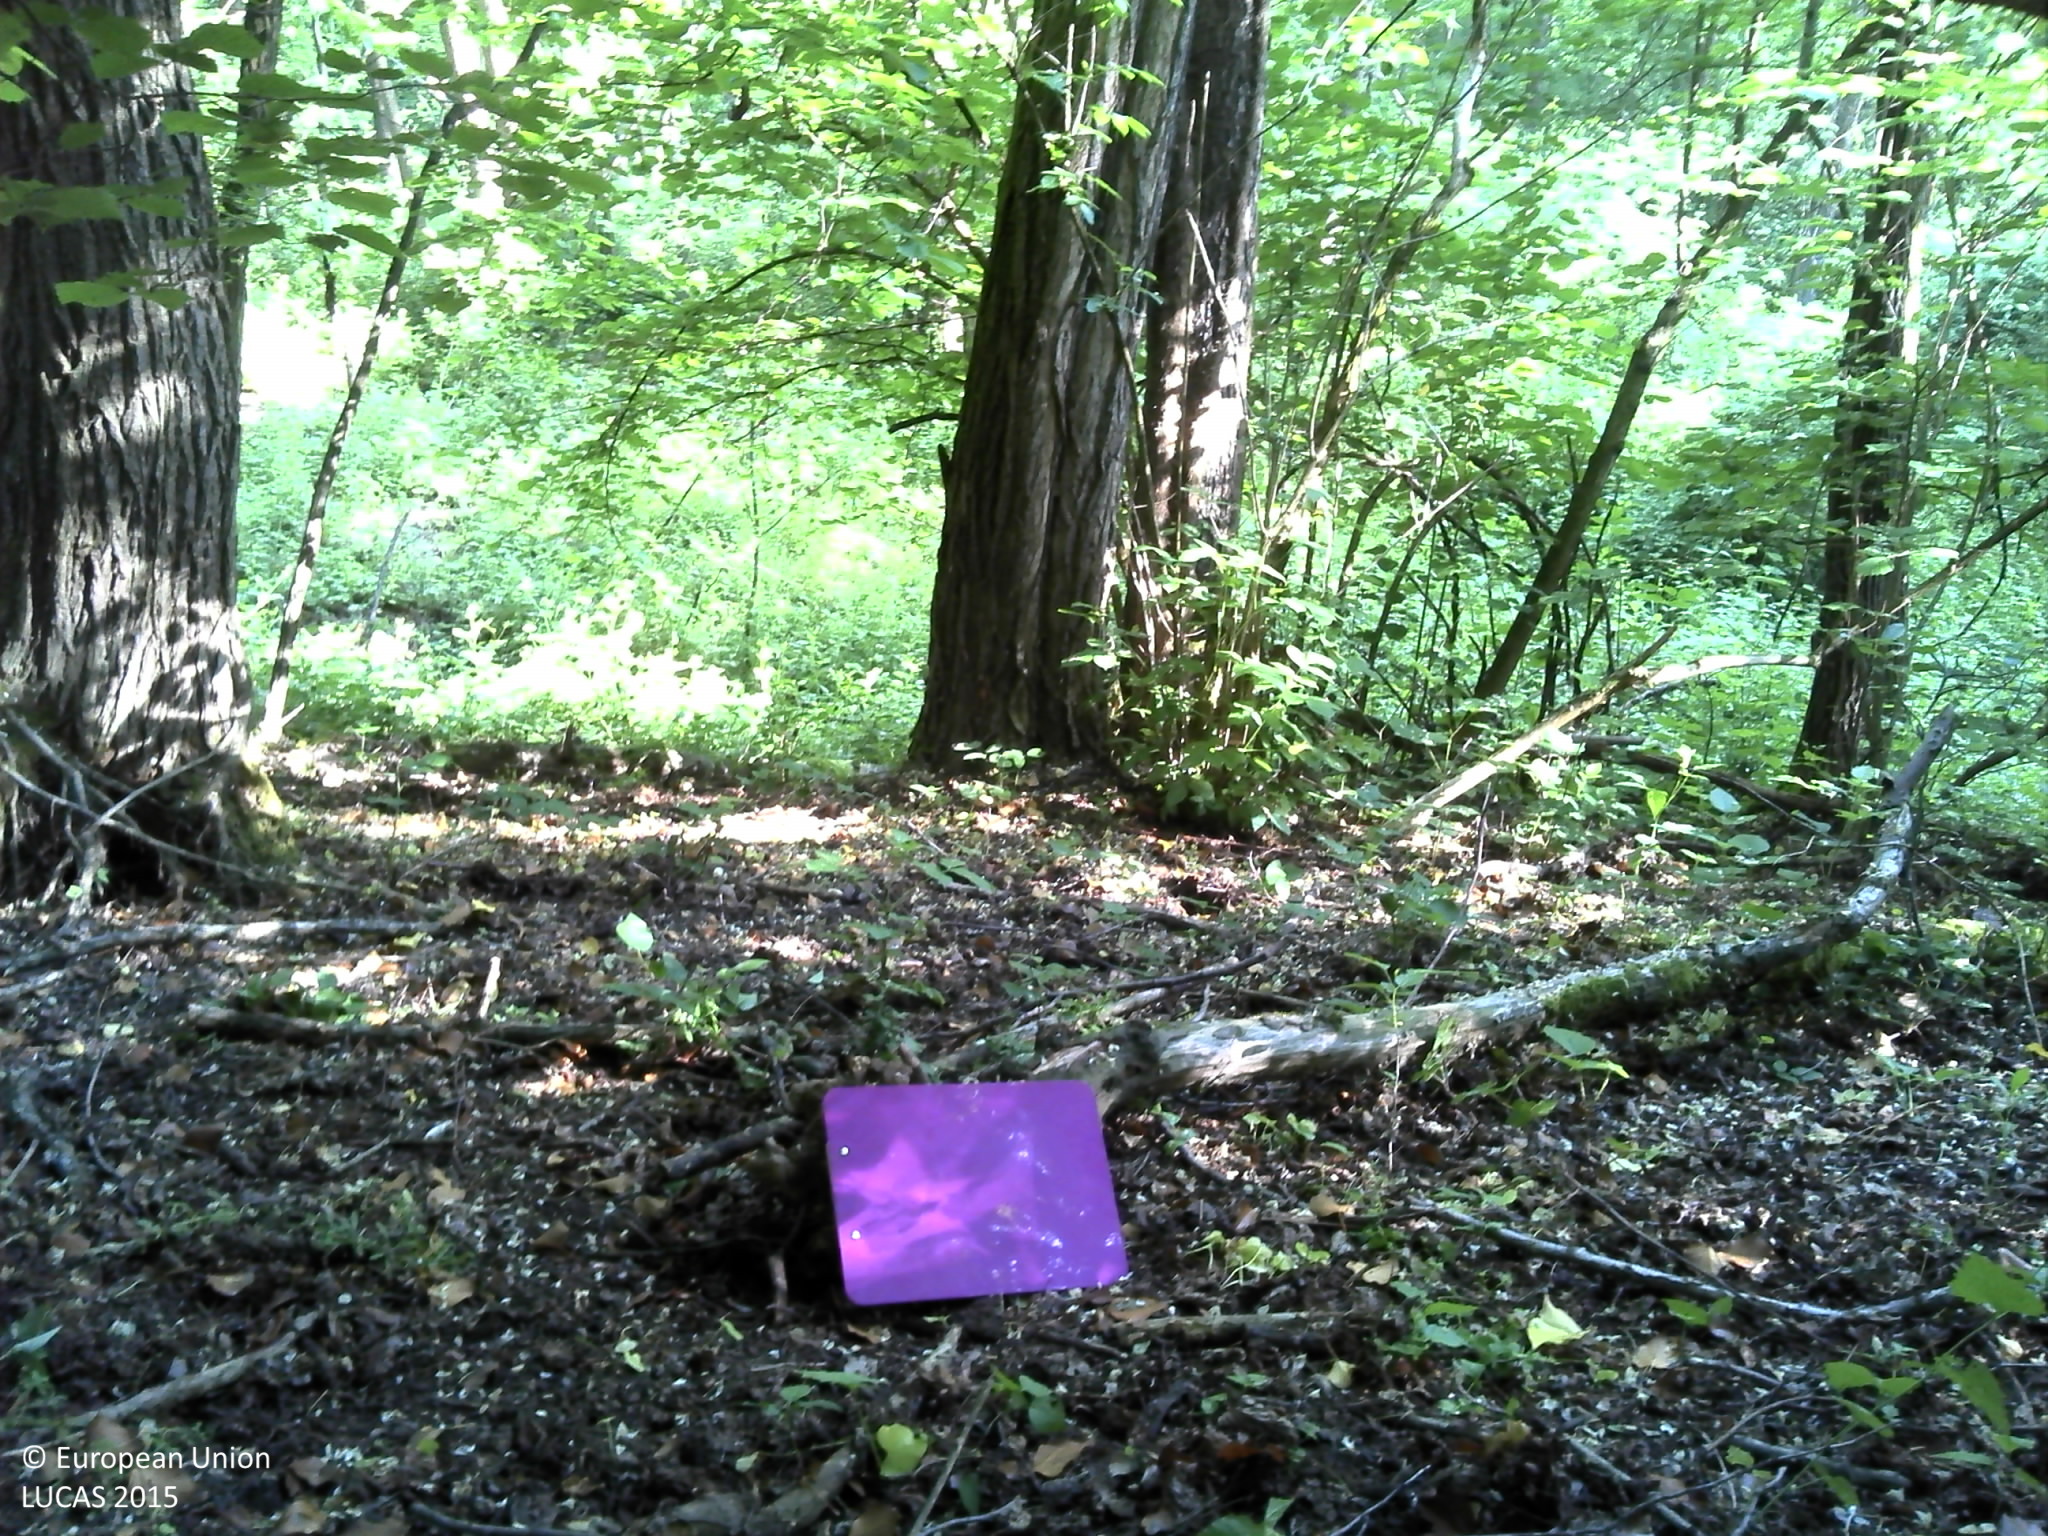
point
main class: Woodland
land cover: Broadleaved woodland
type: mesophytic deciduous forest
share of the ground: > 75 %
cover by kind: broadleaved forest trees 100 %
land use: Forestry
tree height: > 5 m
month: May
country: HR
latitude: 45.4939
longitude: 17.9500
